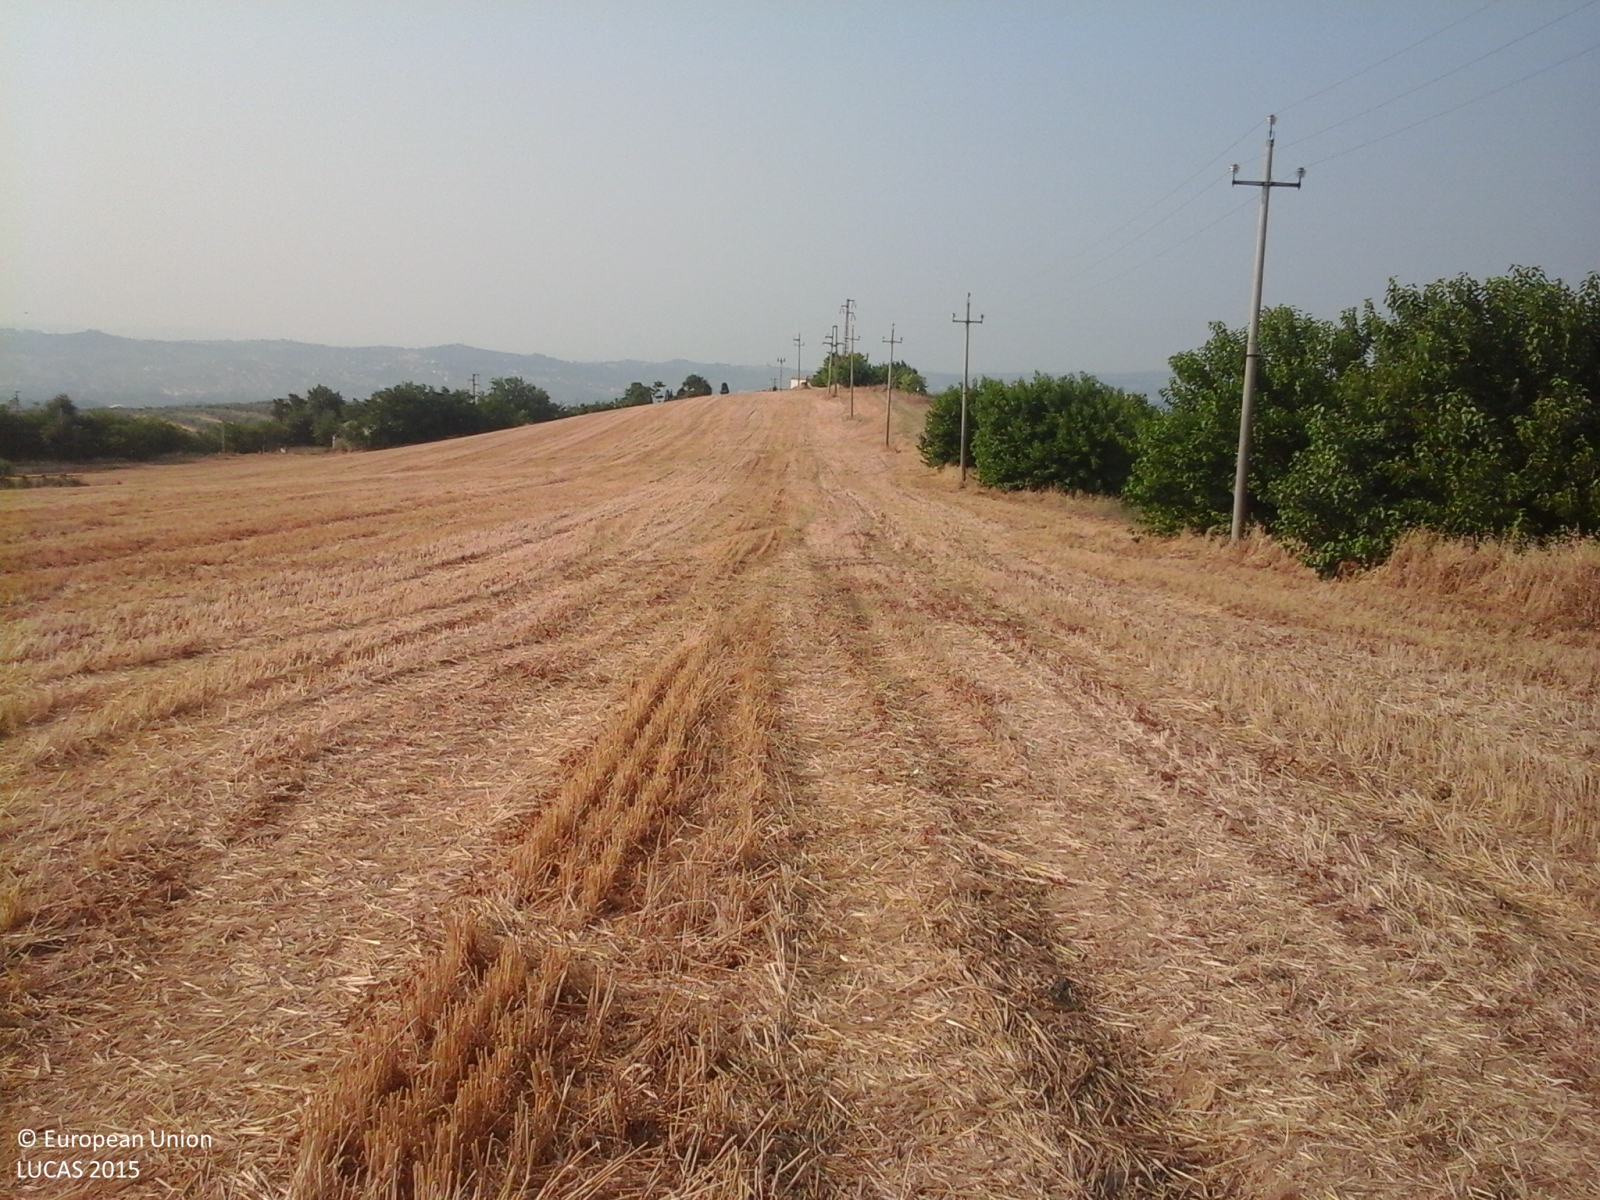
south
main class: Cropland
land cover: Durum wheat
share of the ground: > 75 %
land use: Agriculture (excluding fallow land and kitchen gardens)
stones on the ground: < 10 %
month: August
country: IT
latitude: 42.5172
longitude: 14.0899
